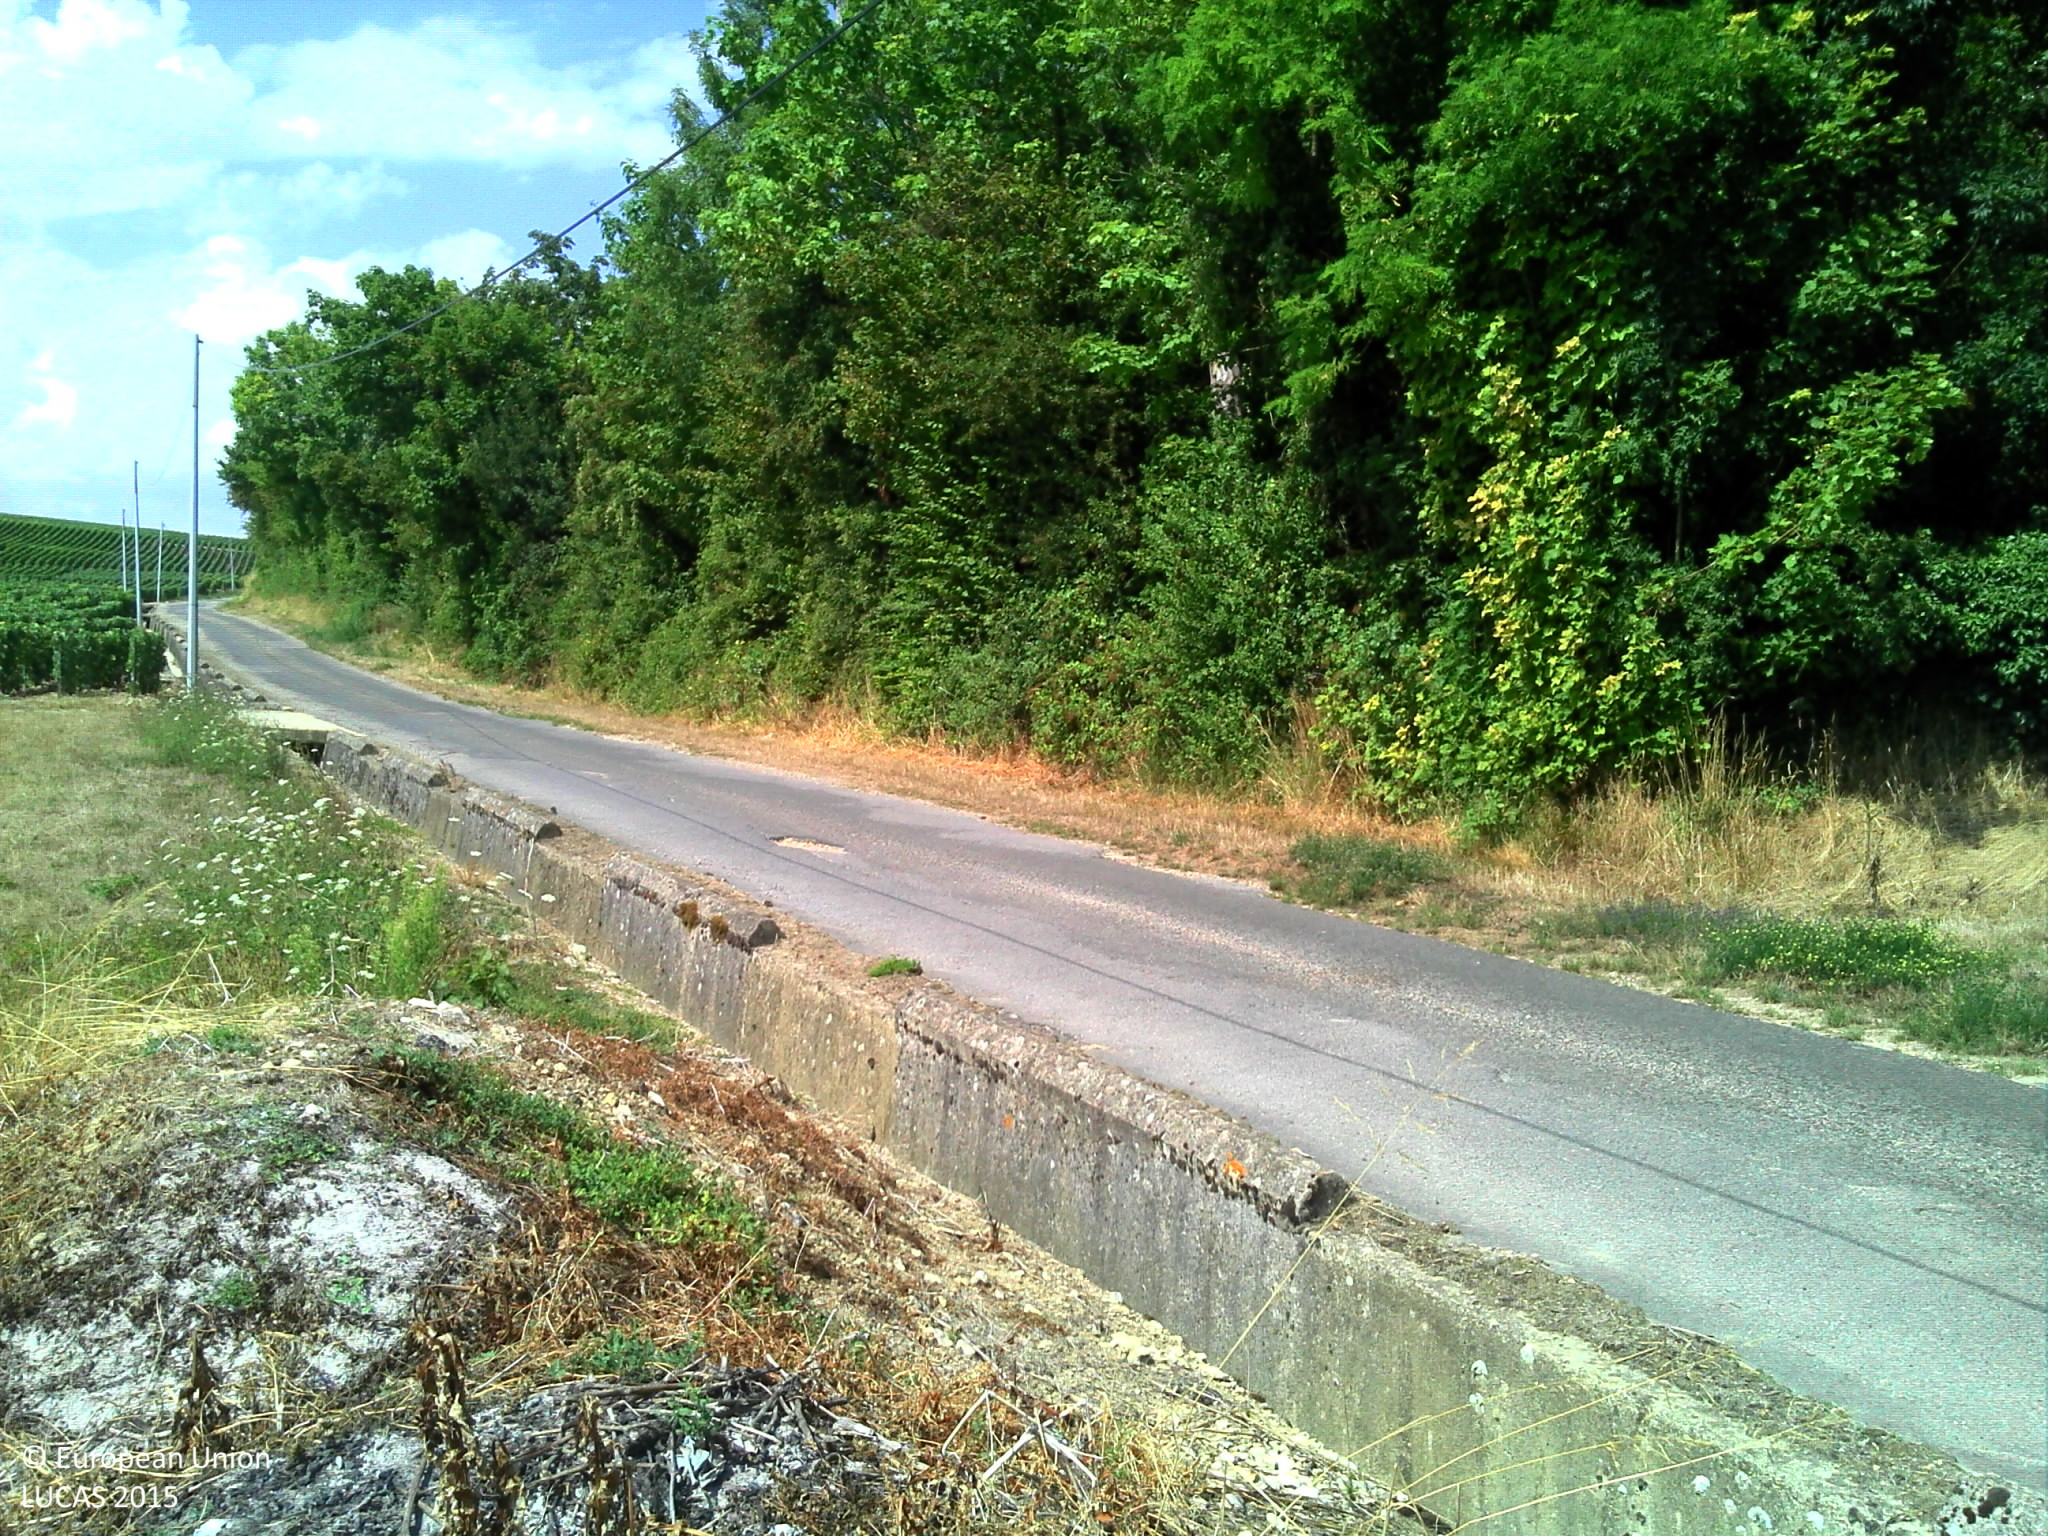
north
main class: Grassland
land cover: Grassland without tree/shrub cover
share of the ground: > 75 %
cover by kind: herbaceous plants 85 %, consolidated bare surface 5 %, unconsolidated bare surface 5 %
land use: Semi-natural and natural areas not in use
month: August
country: FR
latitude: 49.1099
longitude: 3.7336
